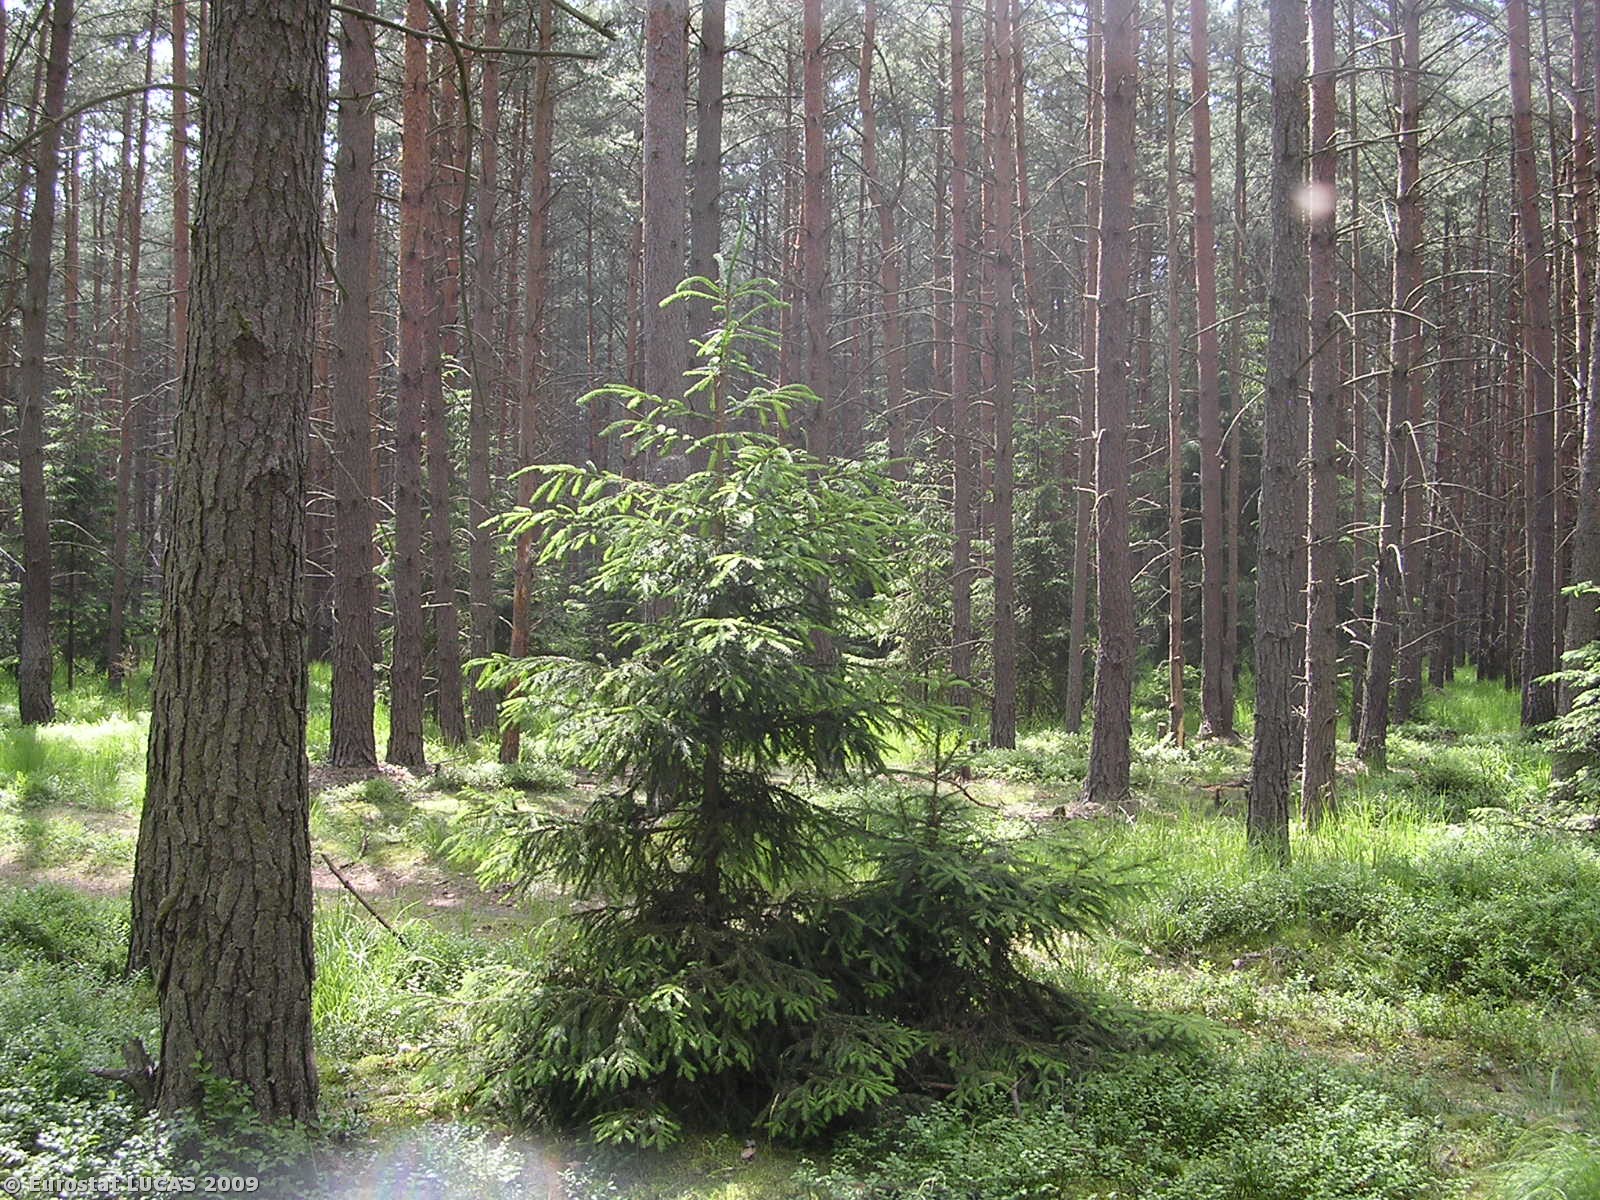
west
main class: Woodland
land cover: Coniferous woodland
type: hemiboreal forest and nemoral coniferous forest and mixed broadleaved-coniferous forest
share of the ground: > 75 %
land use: Forestry
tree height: > 5 m
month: June
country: CZ
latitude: 50.5903
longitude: 14.7343
